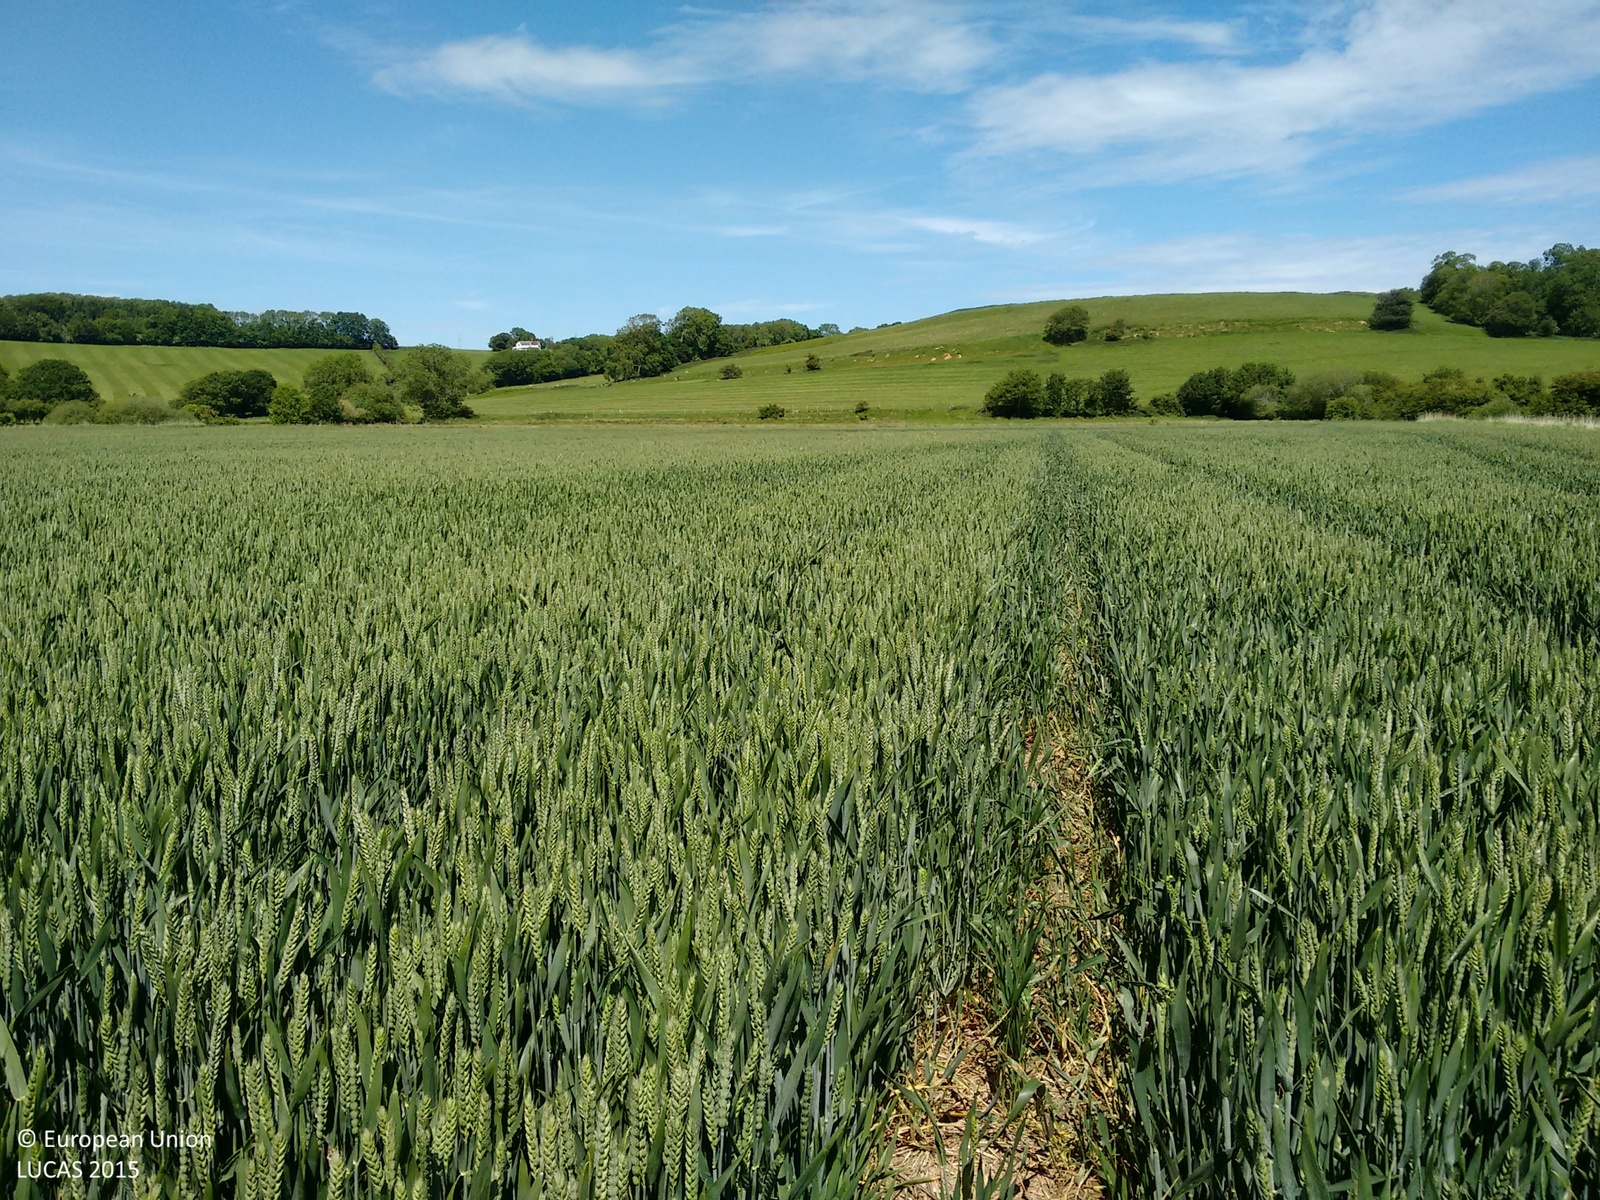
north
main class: Cropland
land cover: Common wheat
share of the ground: > 75 %
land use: Agriculture (excluding fallow land and kitchen gardens)
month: June
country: GB
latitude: 51.0025
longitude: 0.7544
